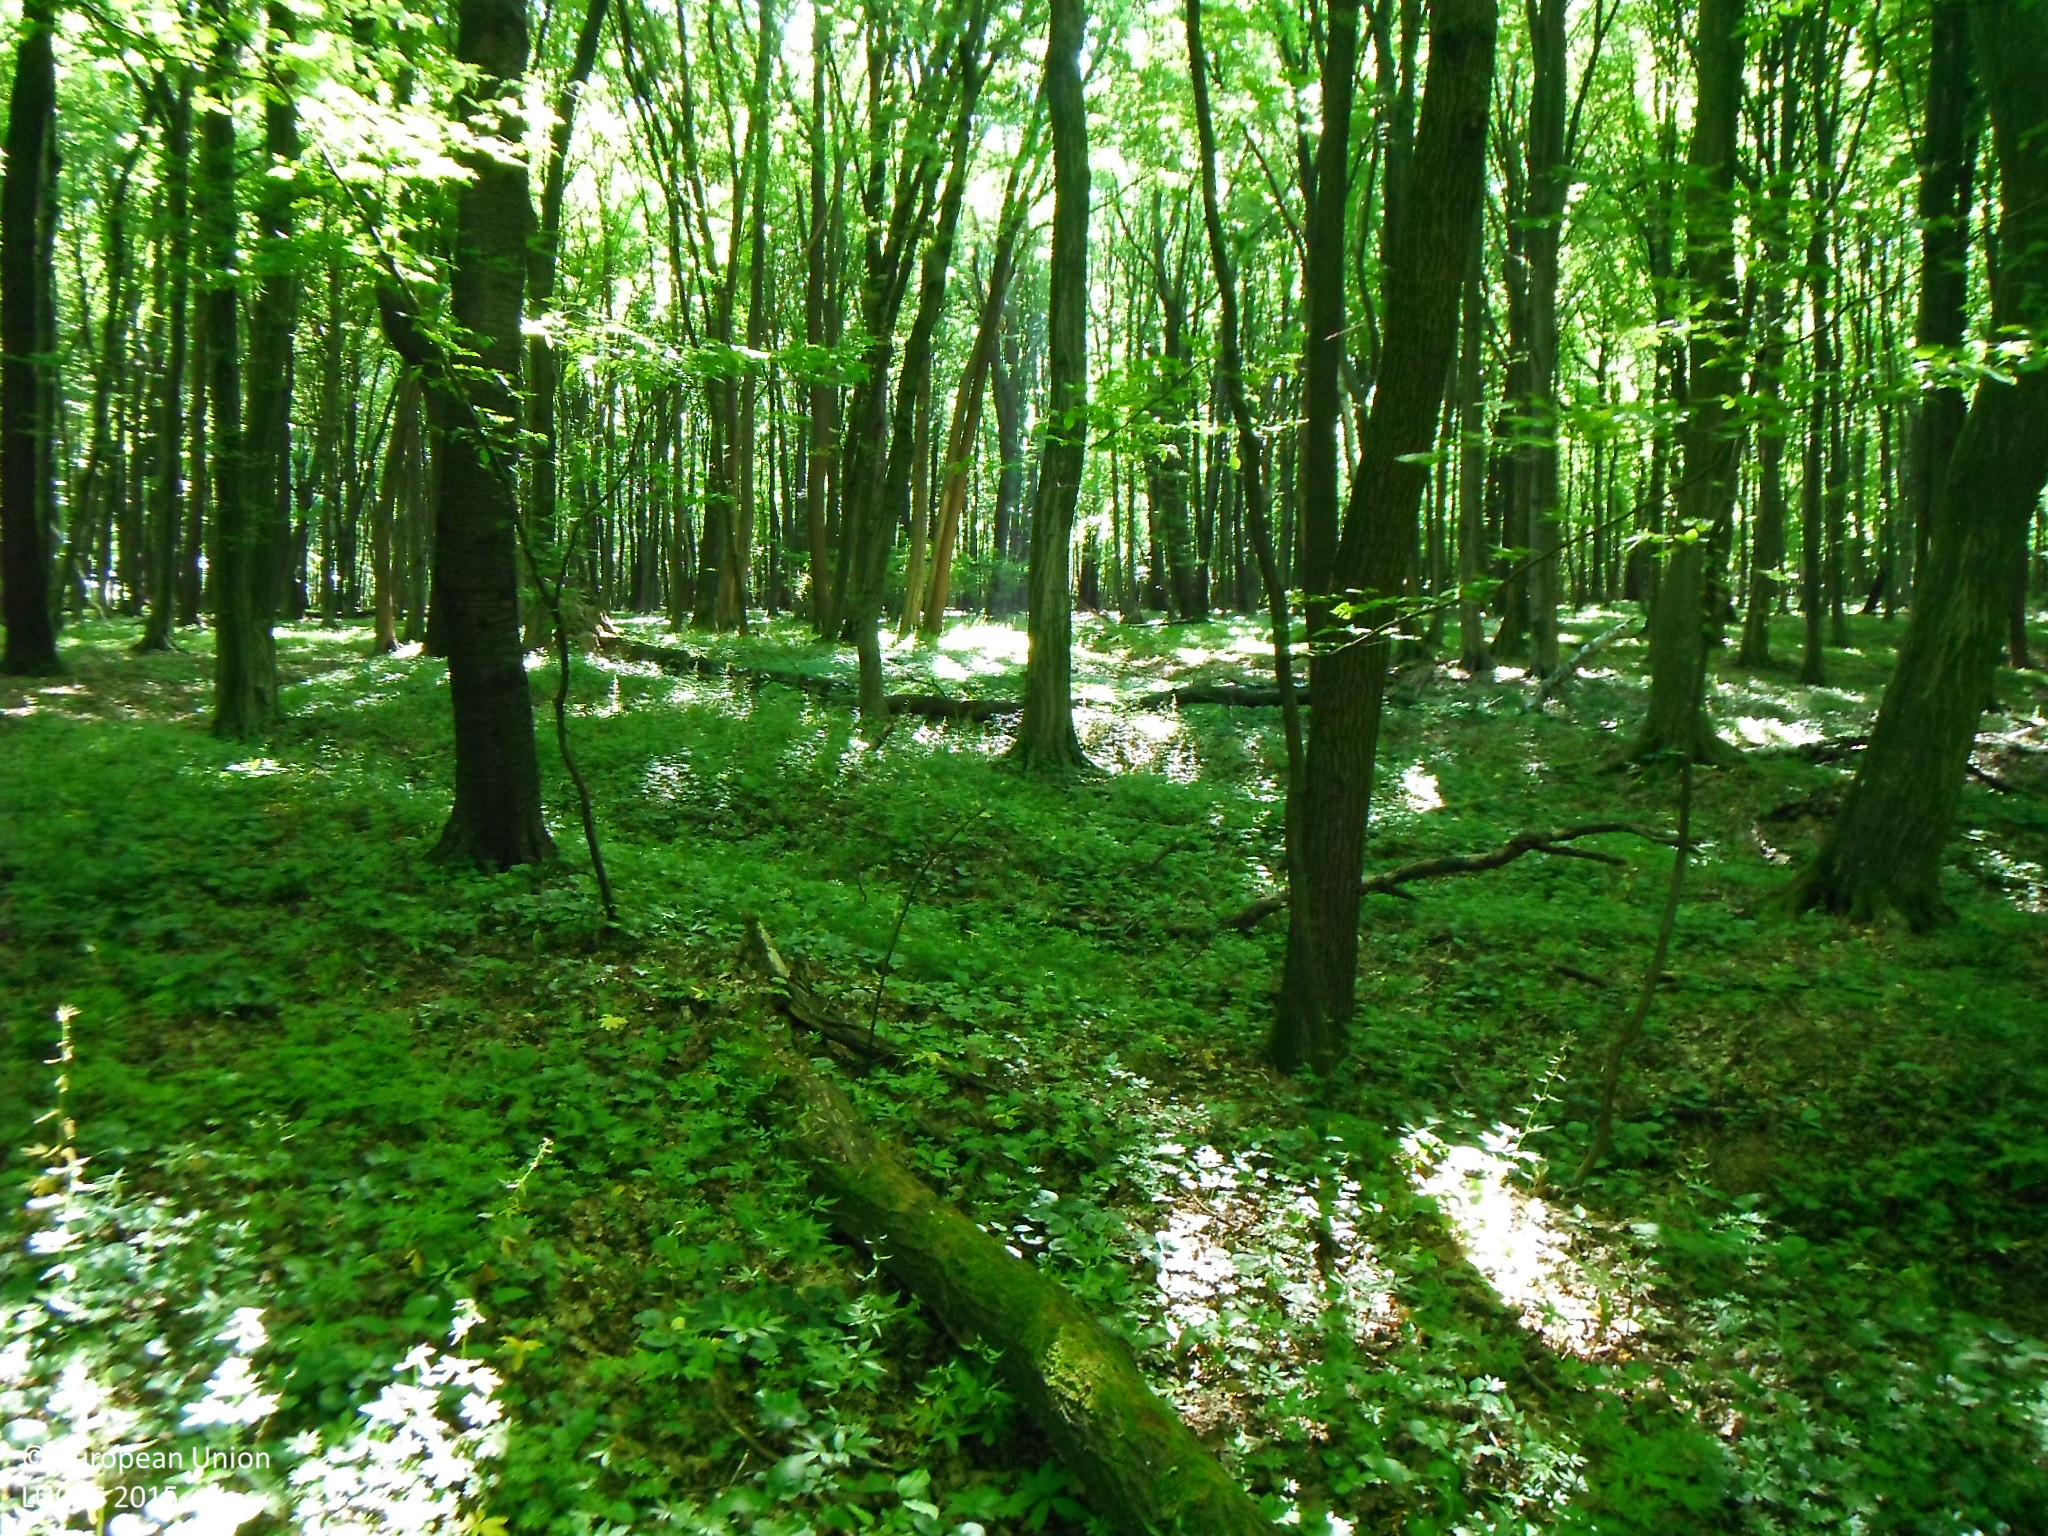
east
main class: Woodland
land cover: Broadleaved woodland
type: mesophytic deciduous forest
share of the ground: > 75 %
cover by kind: broadleaved forest trees 100 %
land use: Forestry
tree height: > 5 m
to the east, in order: Broadleaved woodland; Other mixed woodland; Broadleaved woodland
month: June
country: SK
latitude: 48.9323
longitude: 21.2796
